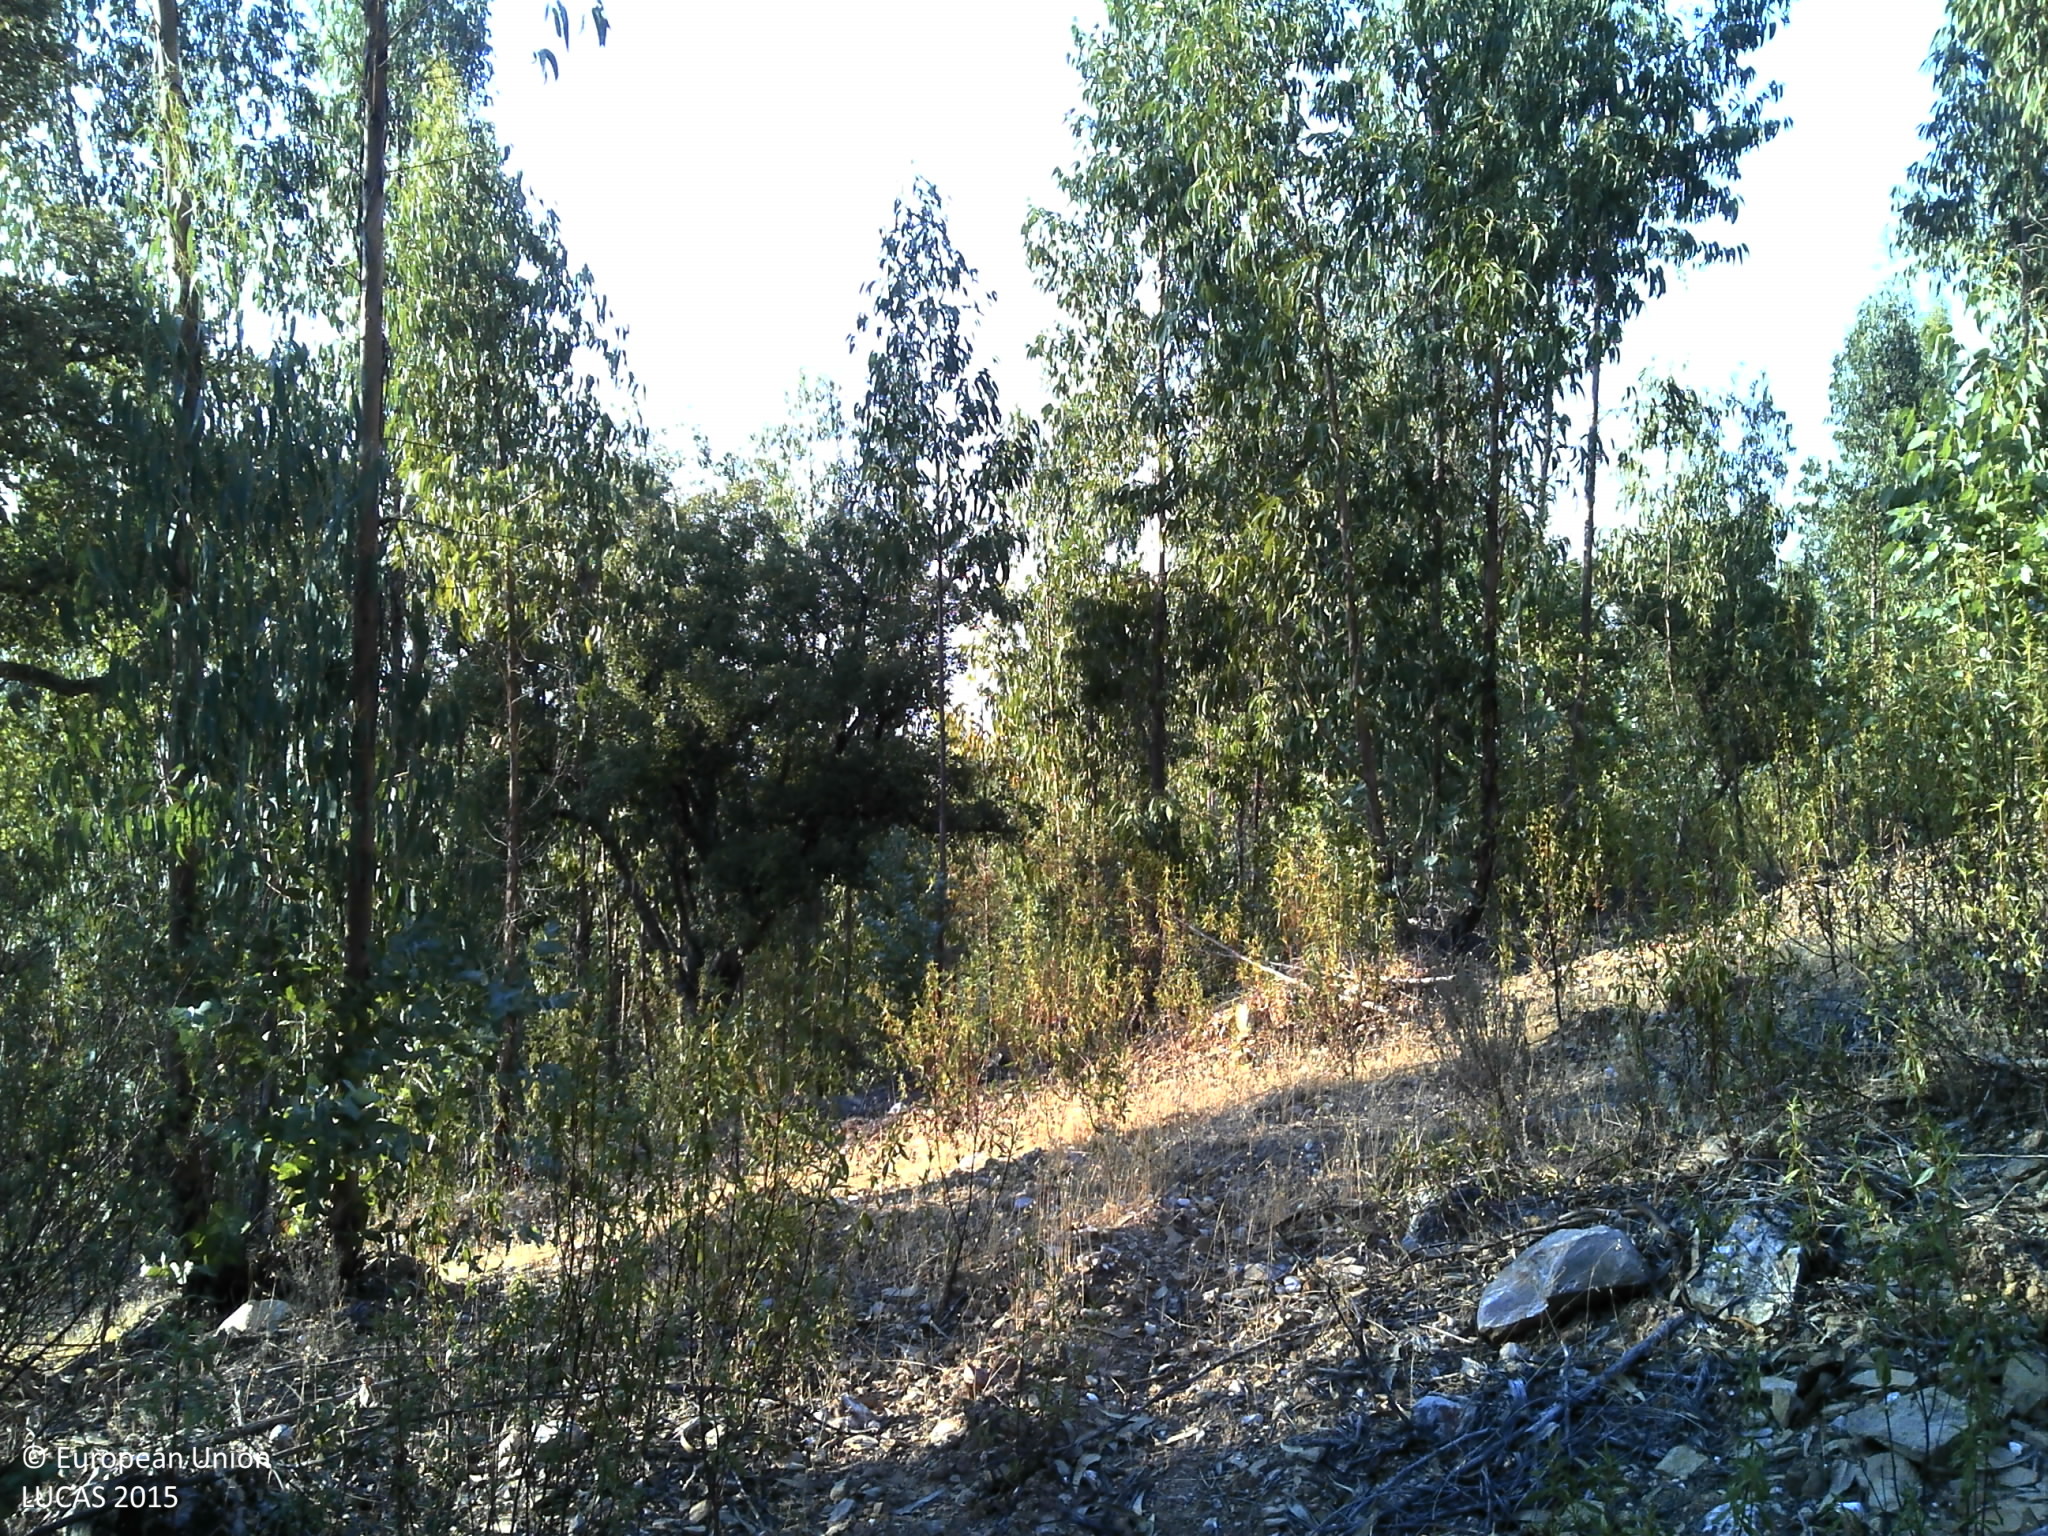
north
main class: Woodland
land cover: Broadleaved woodland
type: exotic forest
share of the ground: > 75 %
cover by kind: broadleaved forest trees 75 %, shrubs 25 %
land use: Forestry
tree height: > 5 m
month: August
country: PT
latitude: 39.6127
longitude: -7.6523
